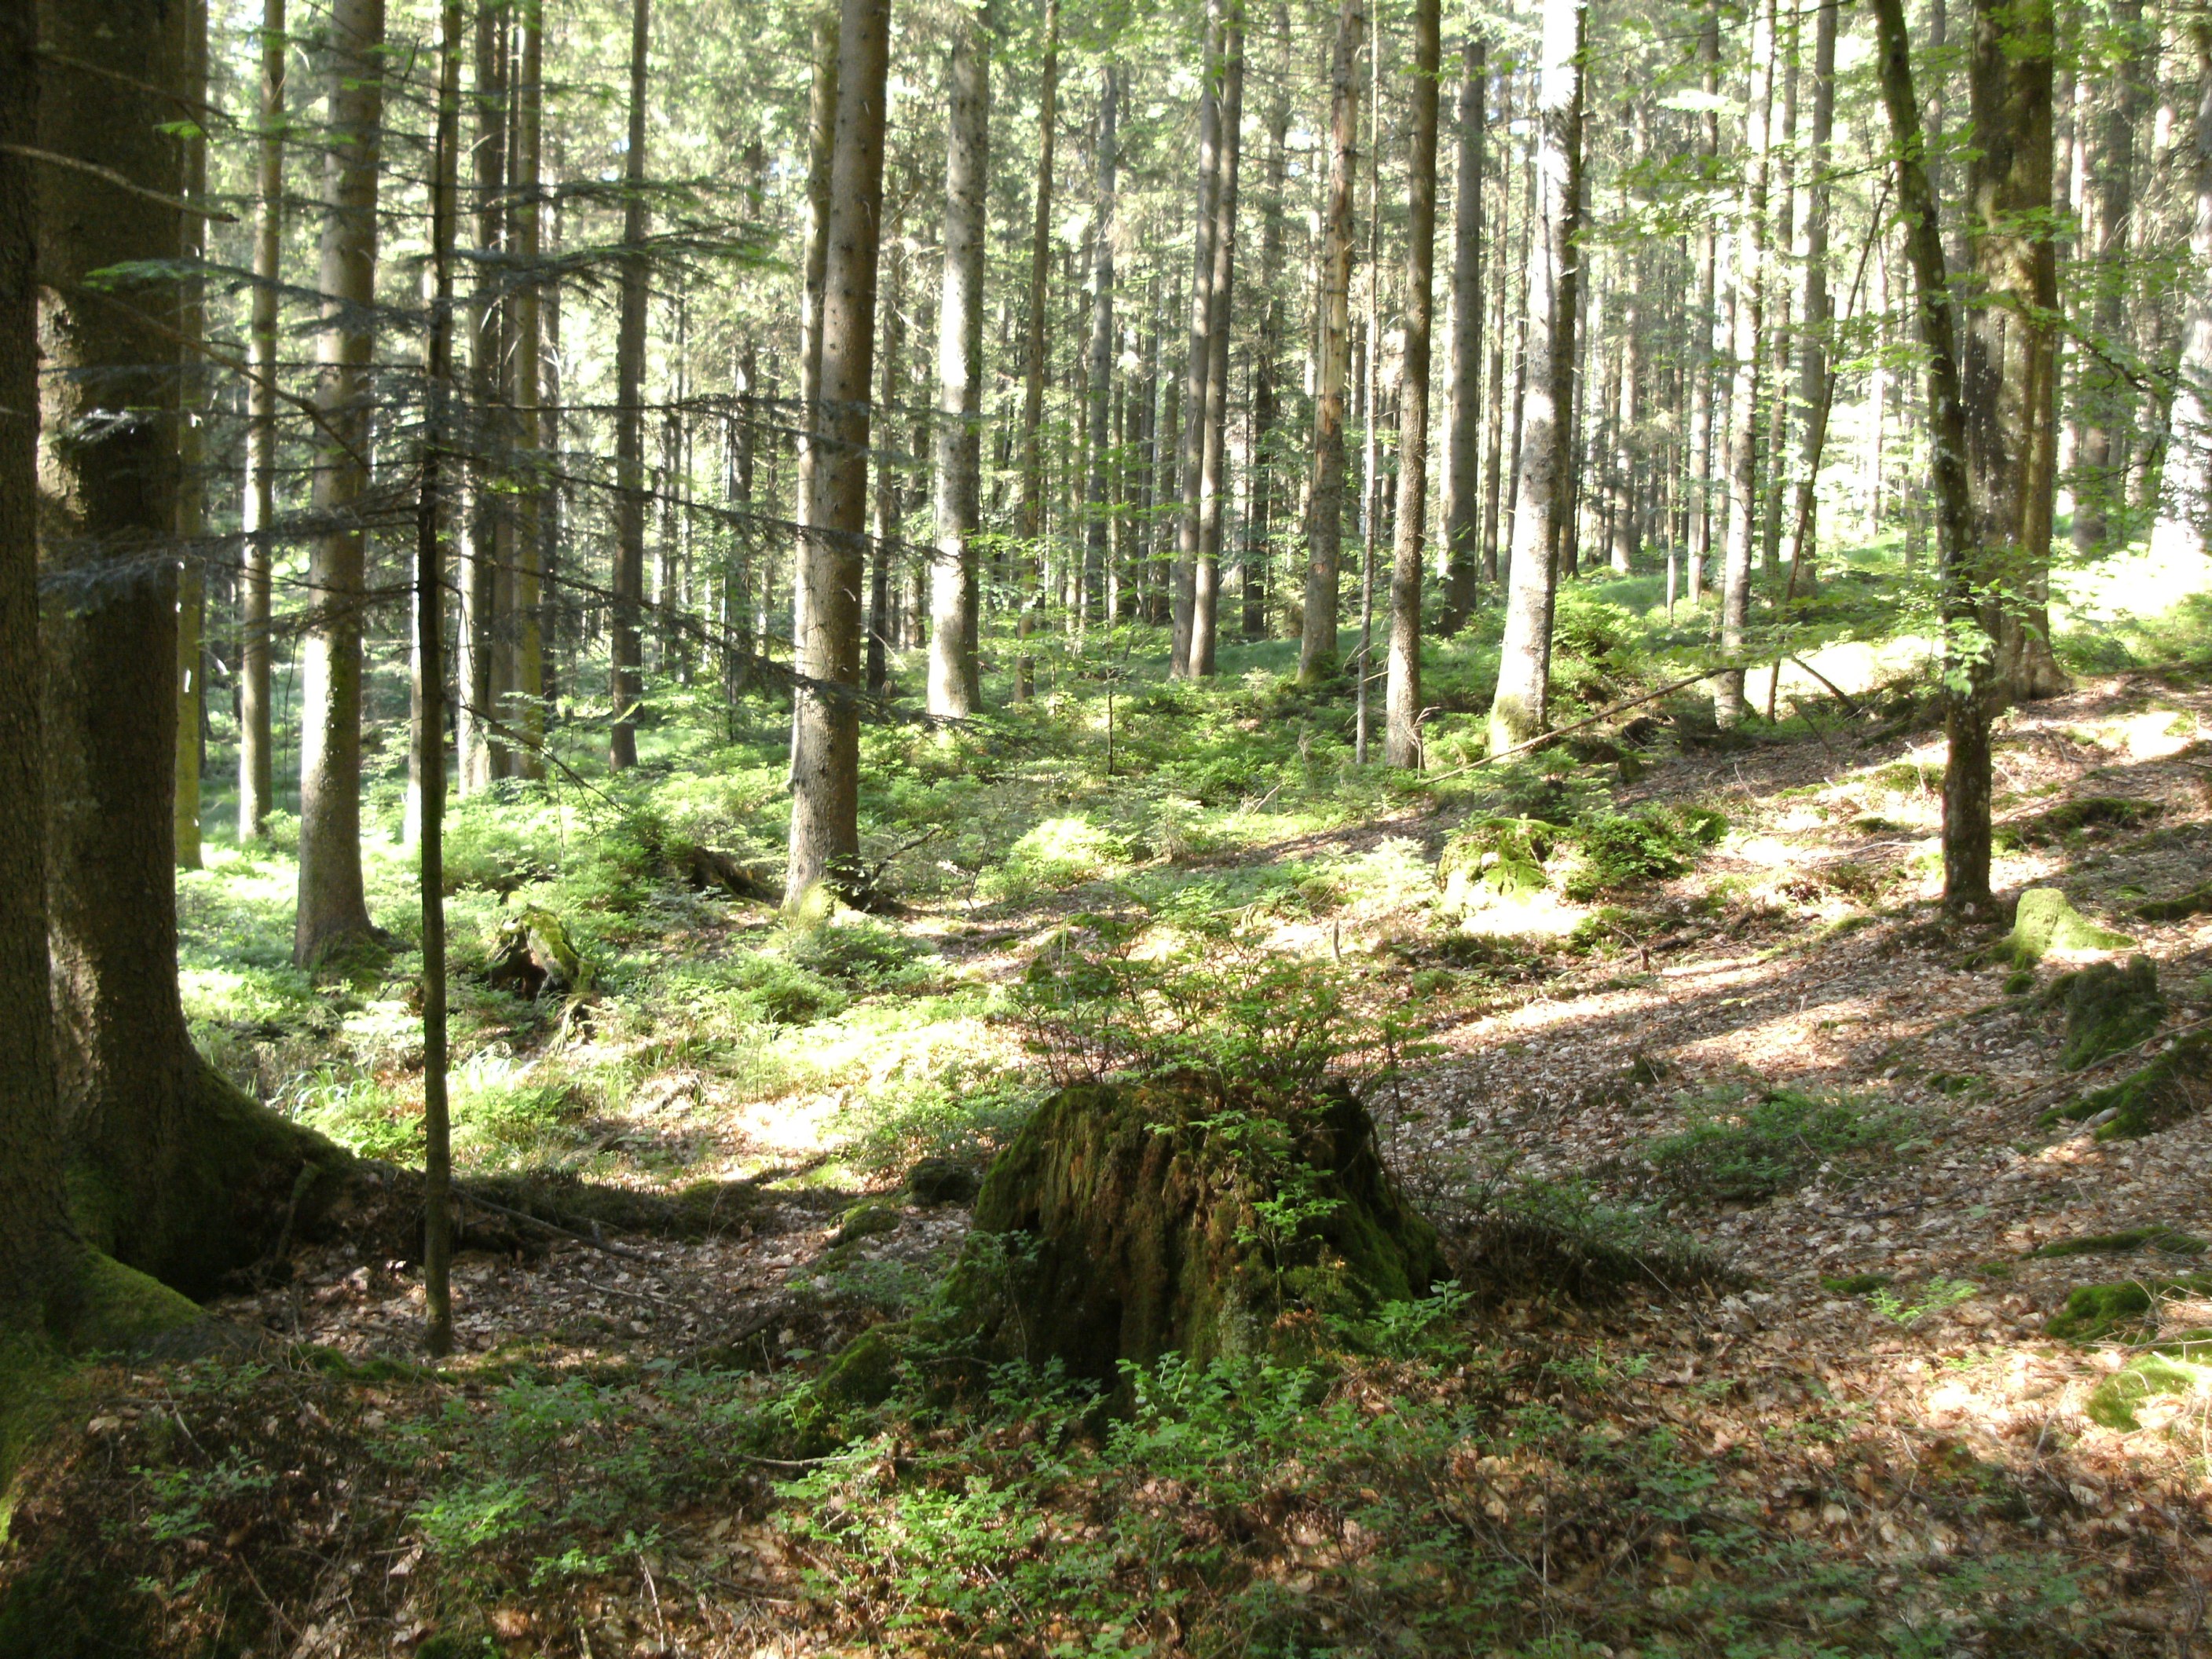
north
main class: Woodland
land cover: Other mixed woodland
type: hemiboreal forest and nemoral coniferous forest and mixed broadleaved-coniferous forest
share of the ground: > 75 %
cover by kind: broadleaved forest trees 55 %, coniferous forest trees 35 %, herbaceous plants 5 %, lichens and mosses 5 %
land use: Forestry
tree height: > 5 m
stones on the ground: < 10 %
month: June
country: AT
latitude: 48.0829
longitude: 13.3416
